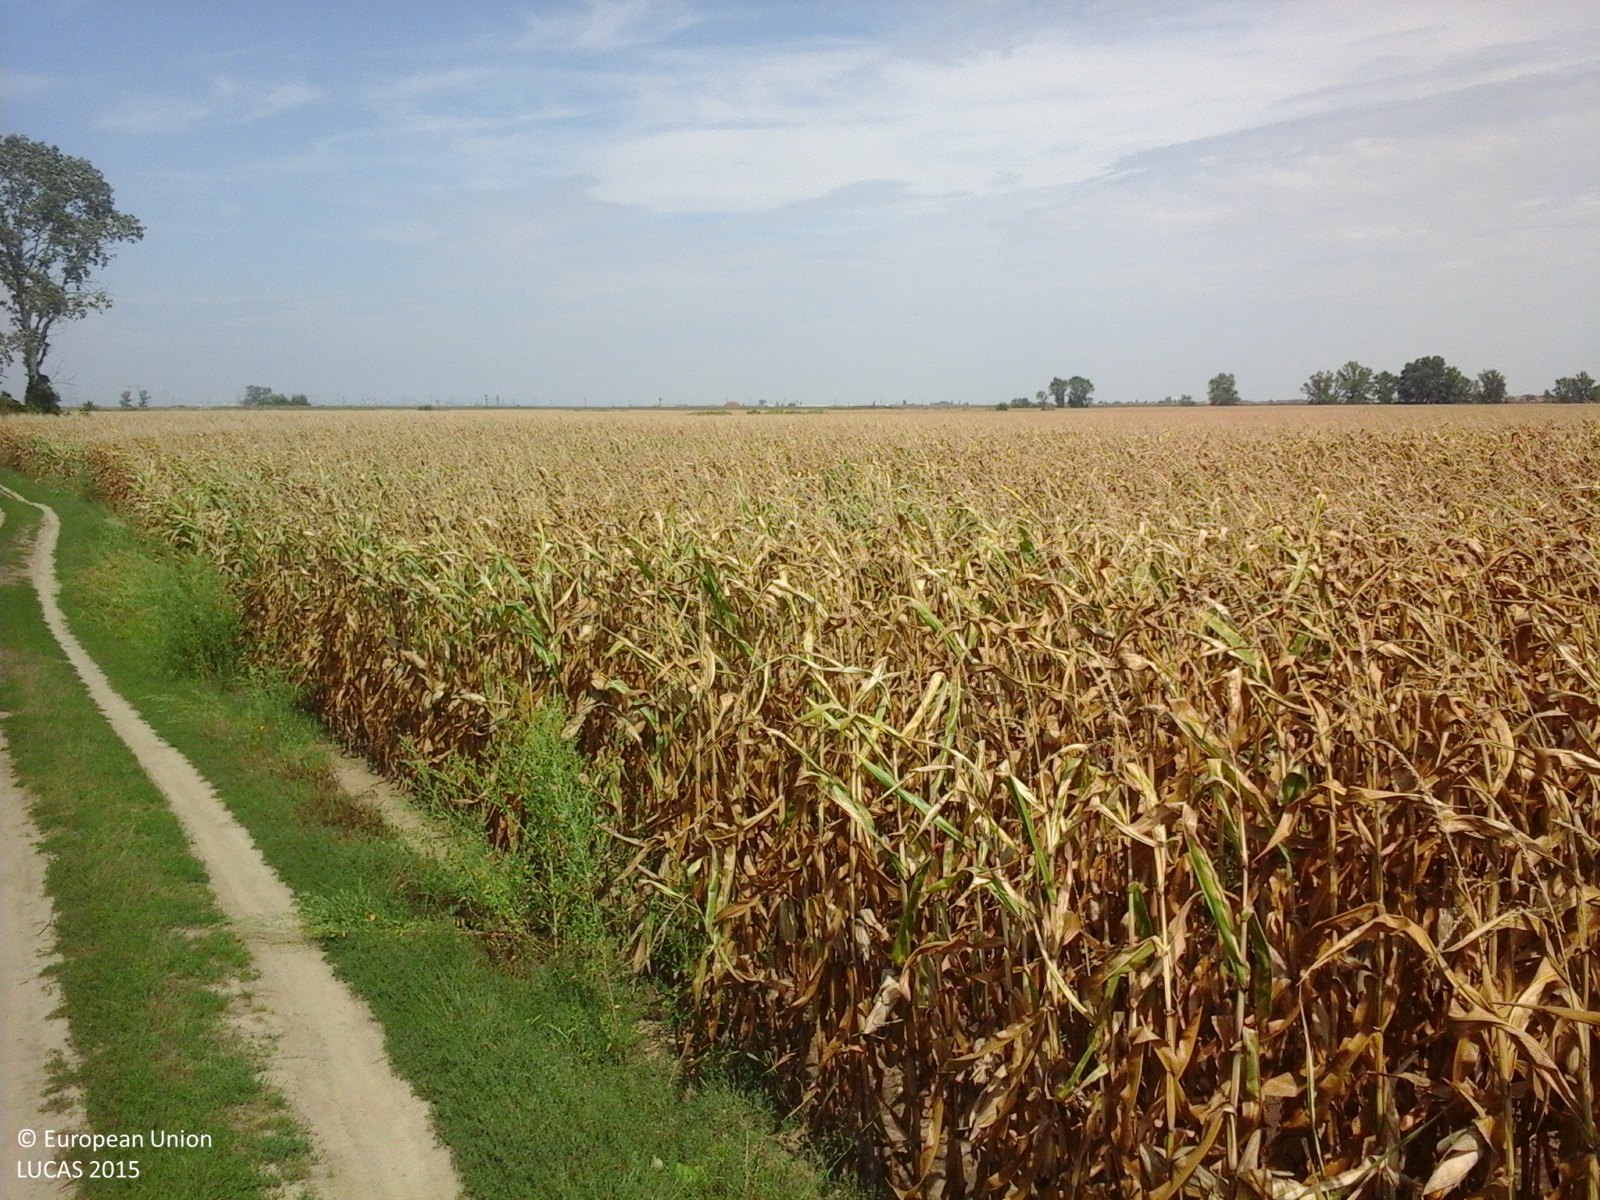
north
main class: Cropland
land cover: Maize
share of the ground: > 75 %
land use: Agriculture (excluding fallow land and kitchen gardens)
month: August
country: RO
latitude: 46.1409
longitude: 21.3876
